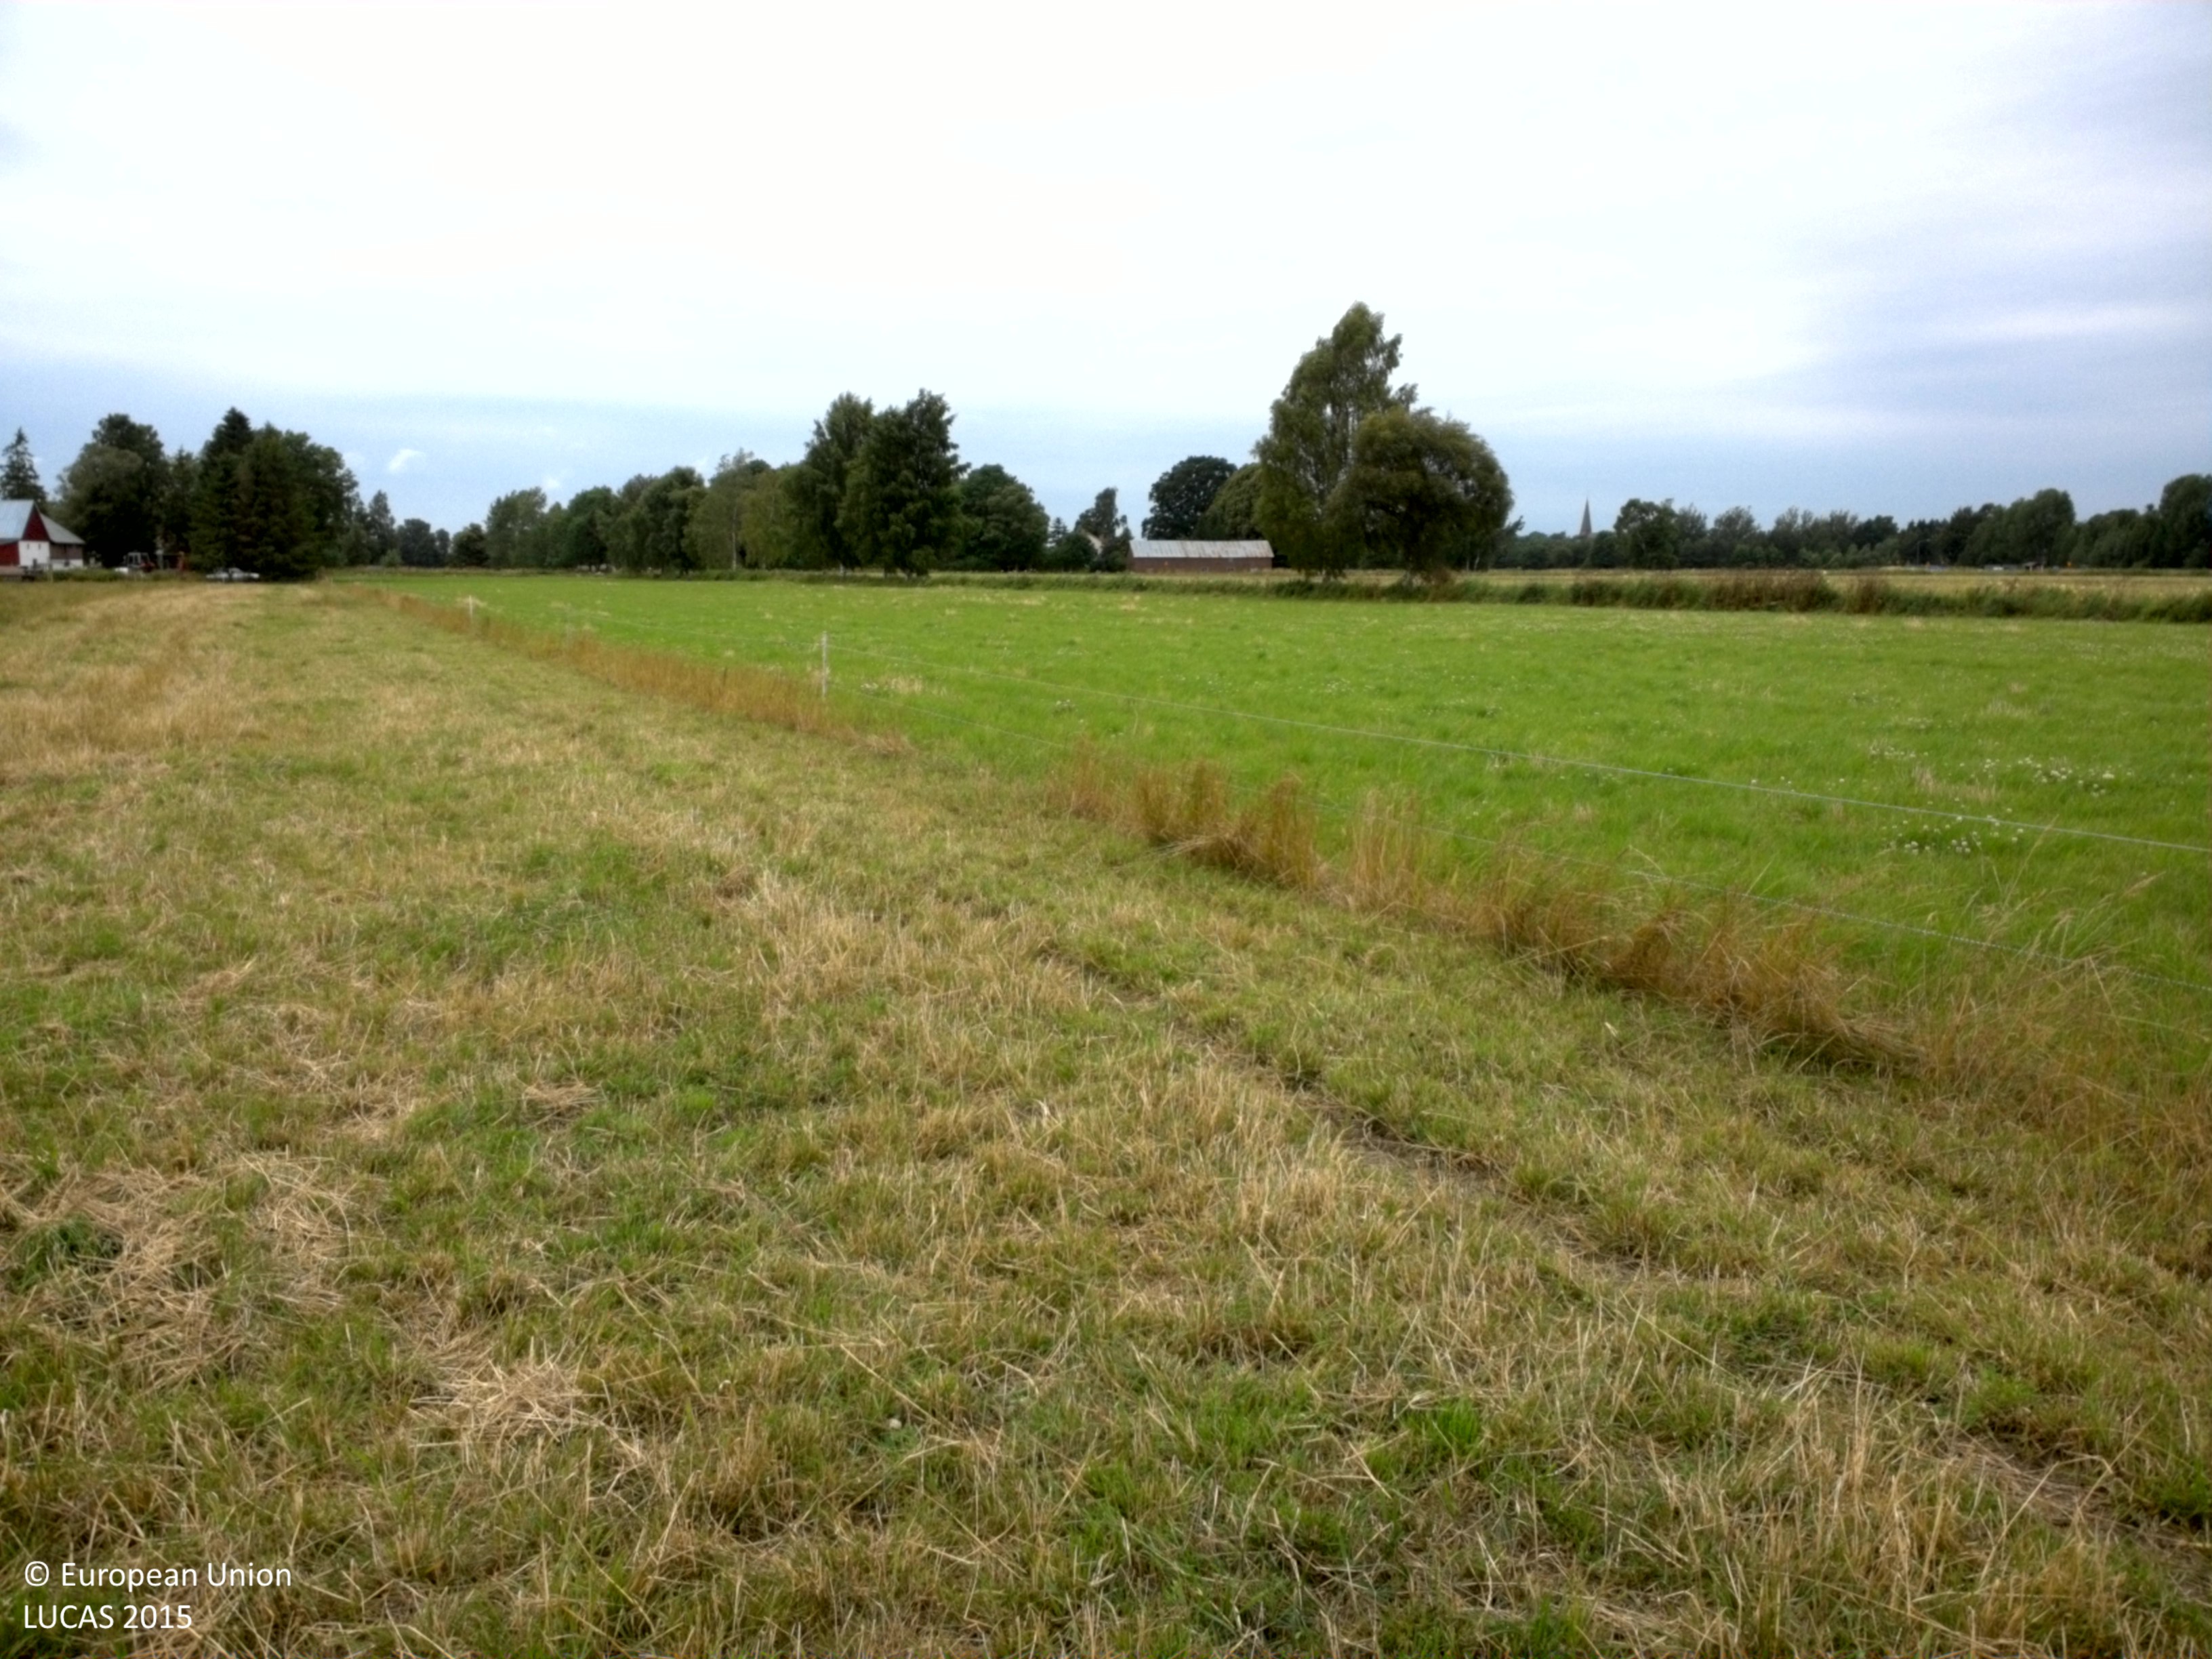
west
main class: Cropland
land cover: Temporary grasslands
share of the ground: > 75 %
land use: Agriculture (excluding fallow land and kitchen gardens)
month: July
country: SE
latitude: 57.2528
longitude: 18.6462
